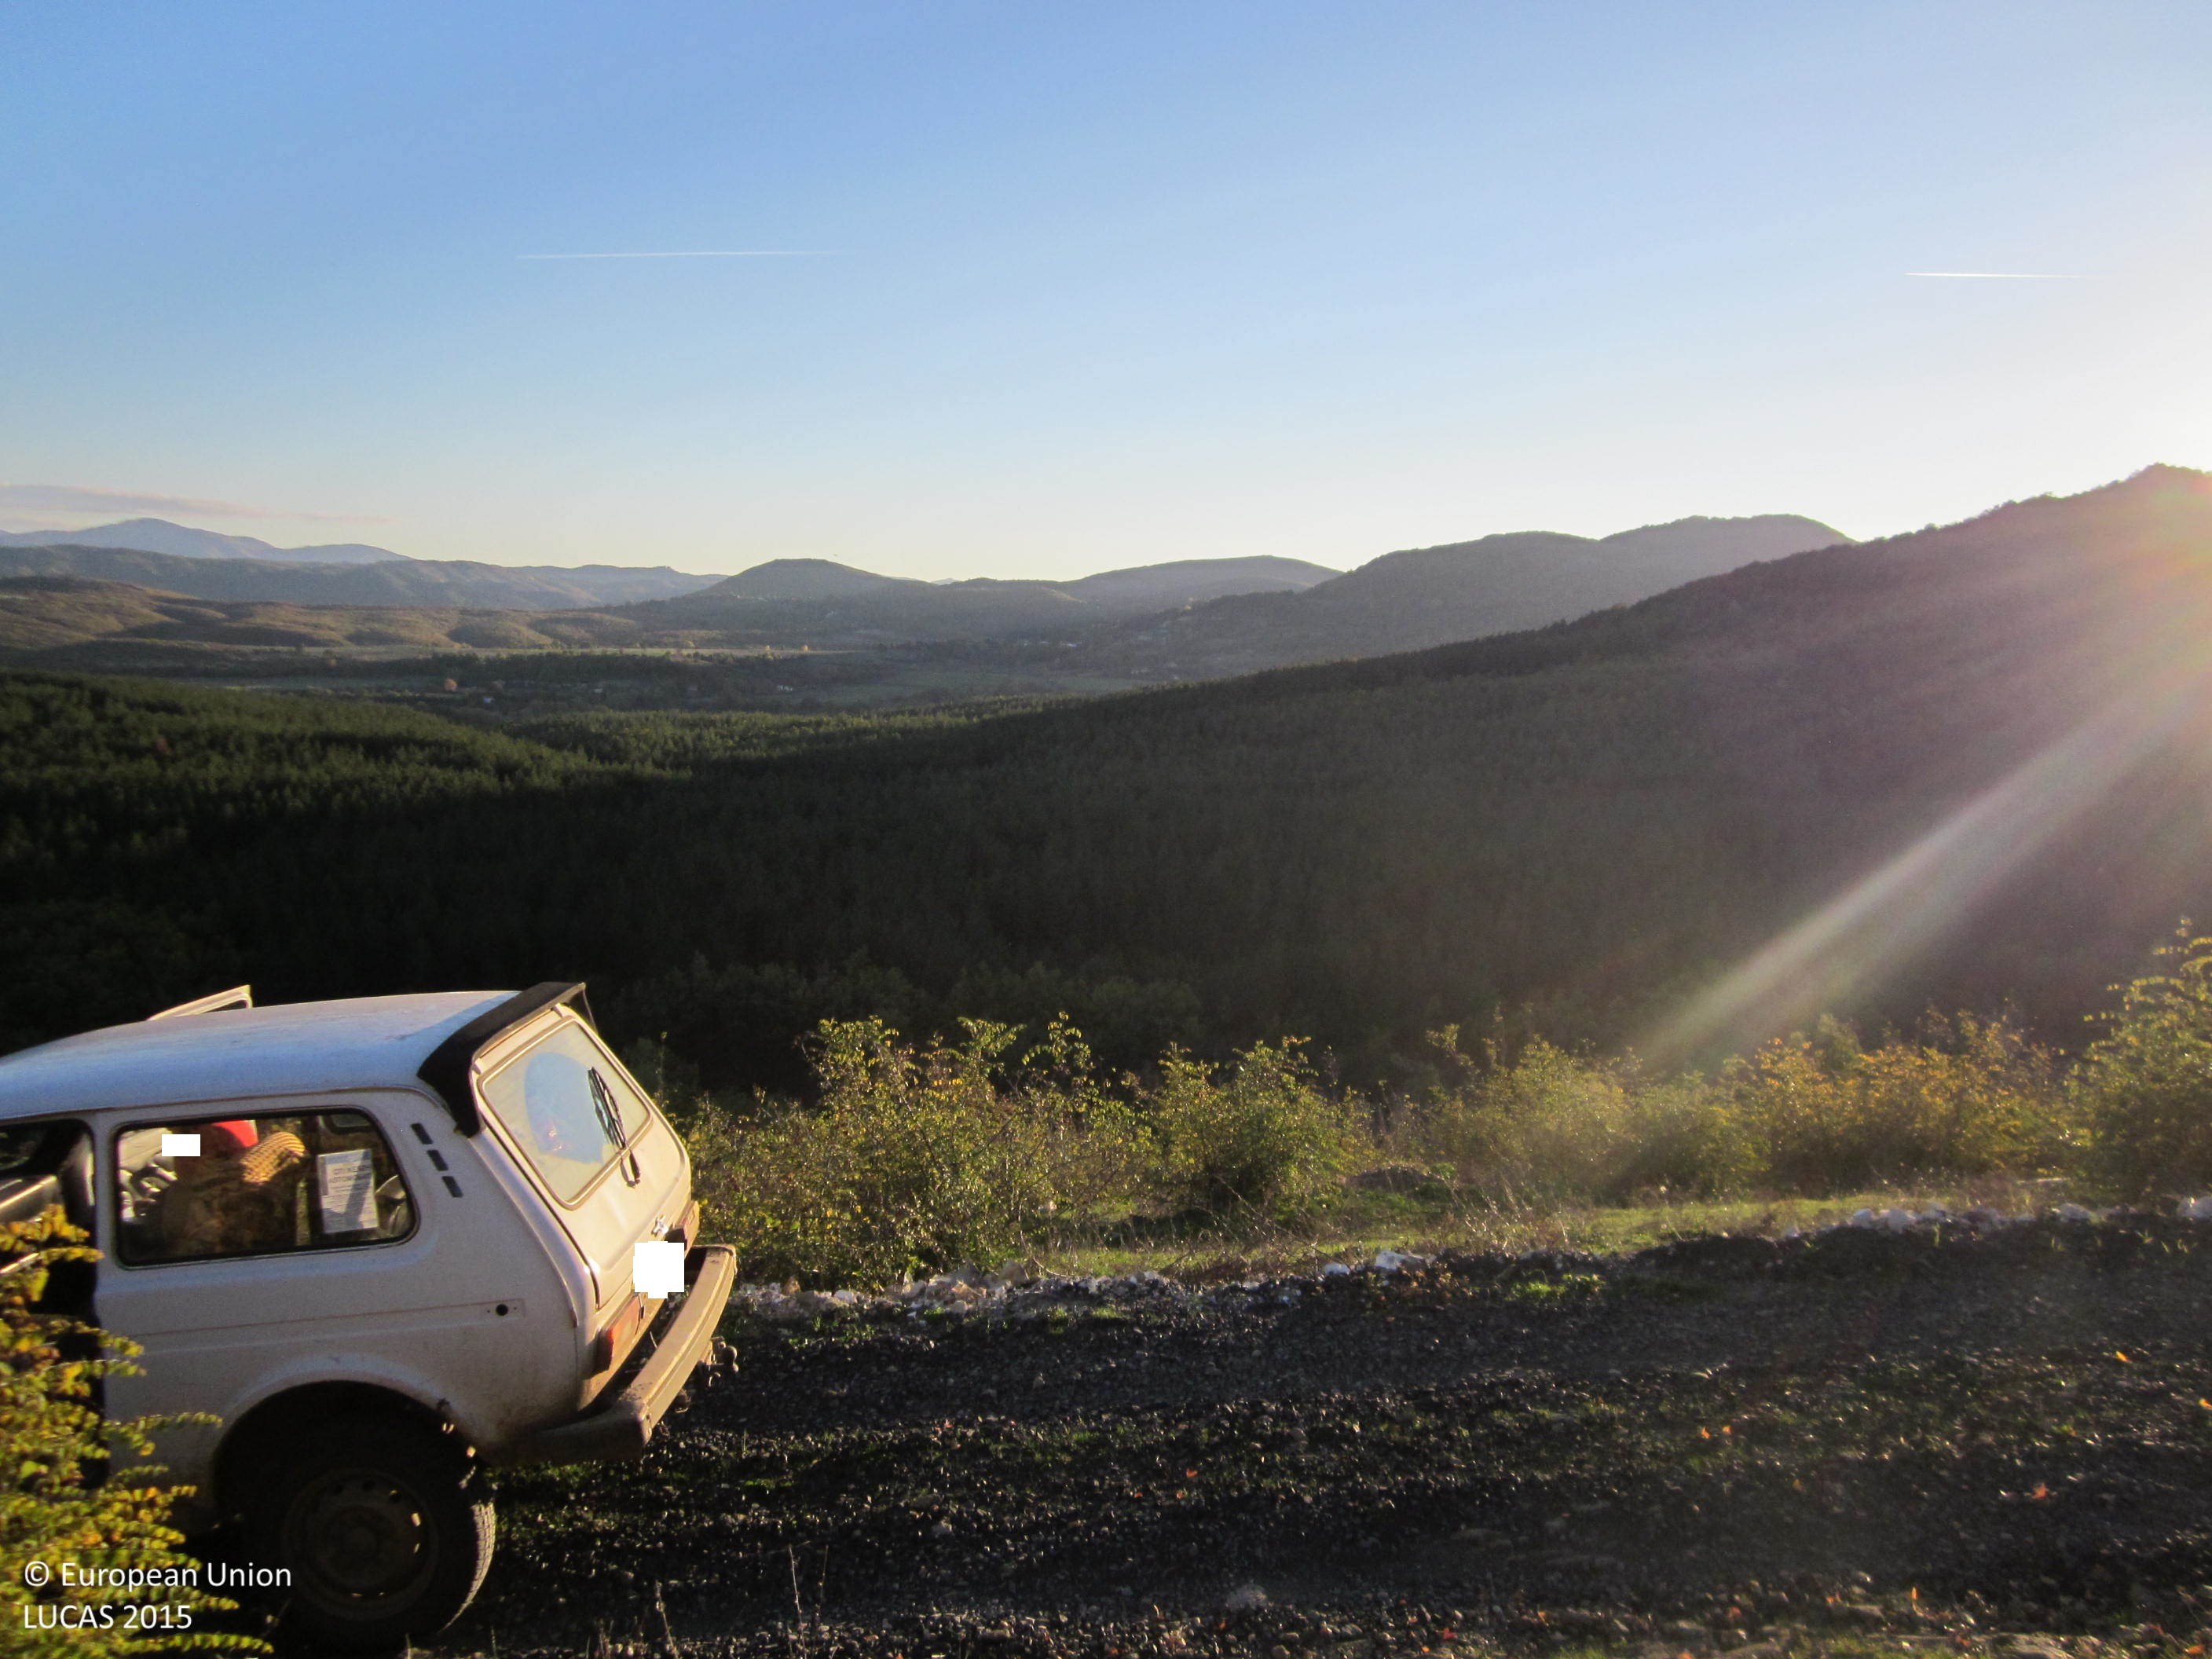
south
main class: Grassland
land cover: Grassland without tree/shrub cover
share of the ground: 50 - 75 %
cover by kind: herbaceous plants 50 %, shrubs 5 %
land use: Residential
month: October
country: BG
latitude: 41.4610
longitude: 25.5623
